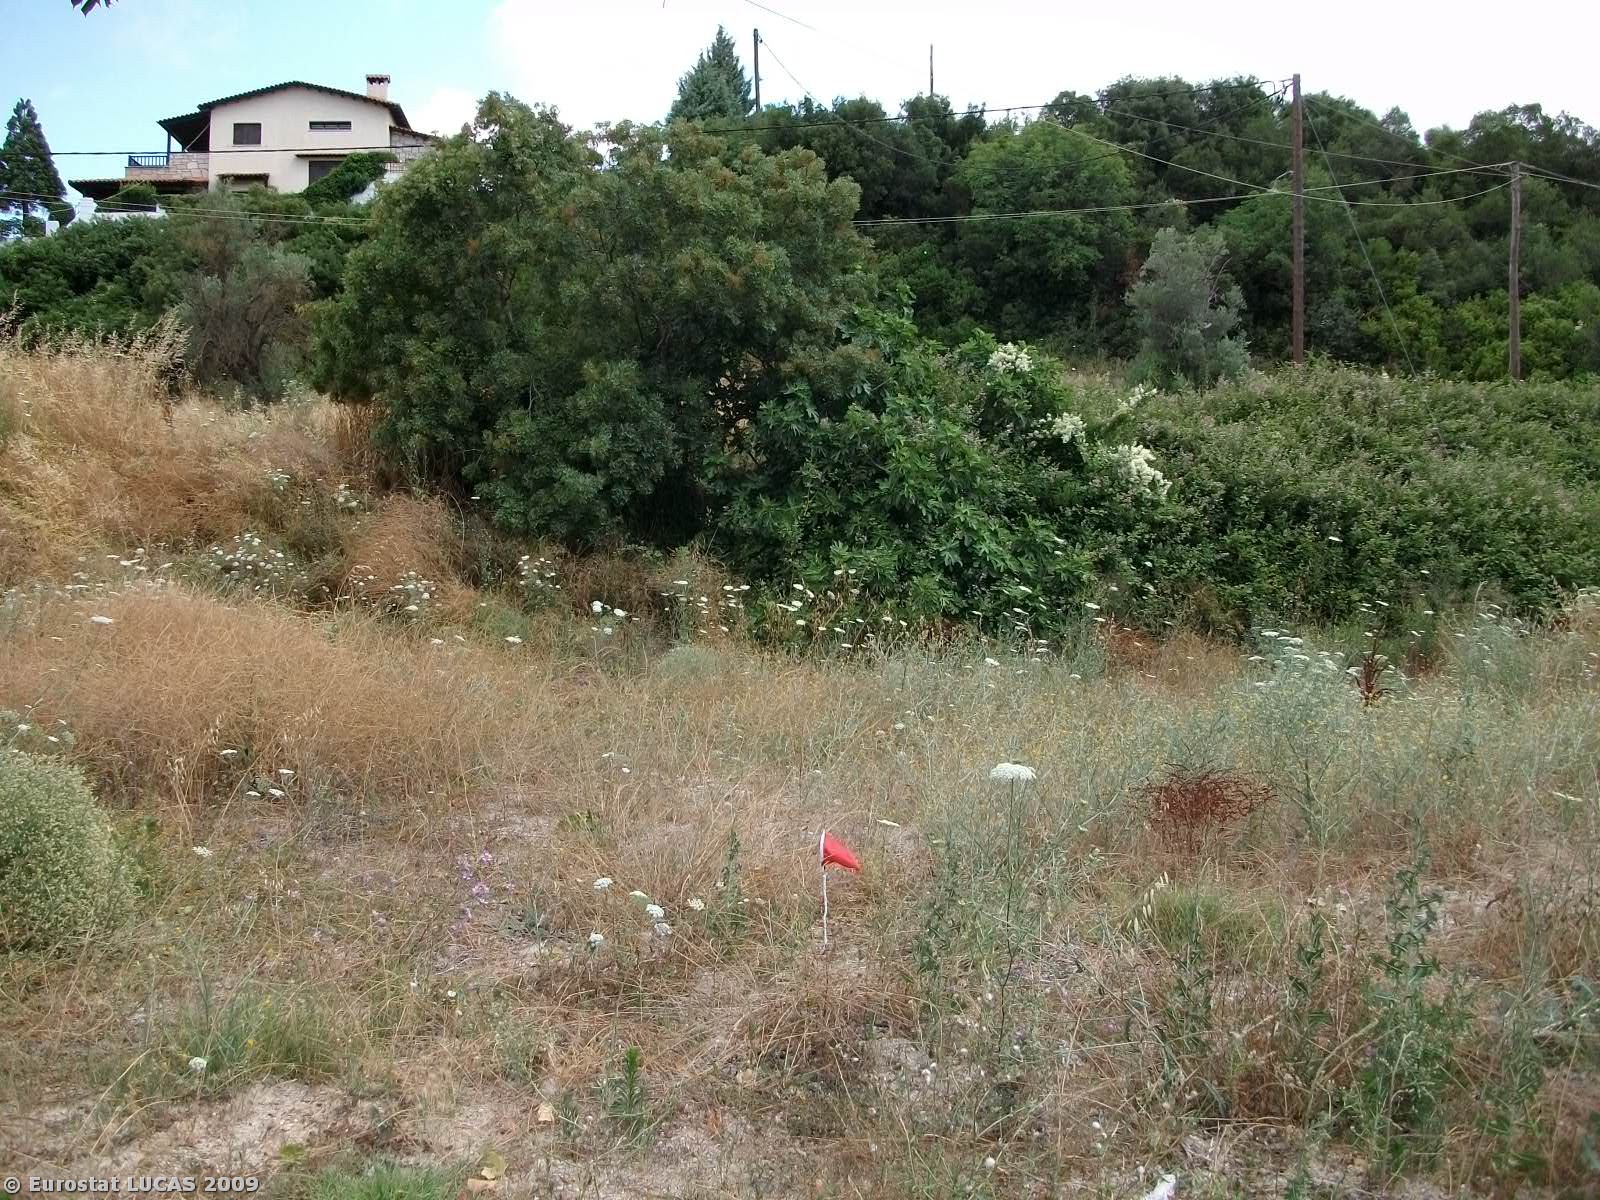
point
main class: Grassland
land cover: Grassland without tree/shrub cover
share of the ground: 10 - 25 %
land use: Unused
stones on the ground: 10 - 25 %
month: June
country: GR
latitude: 40.0150
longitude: 23.4436
